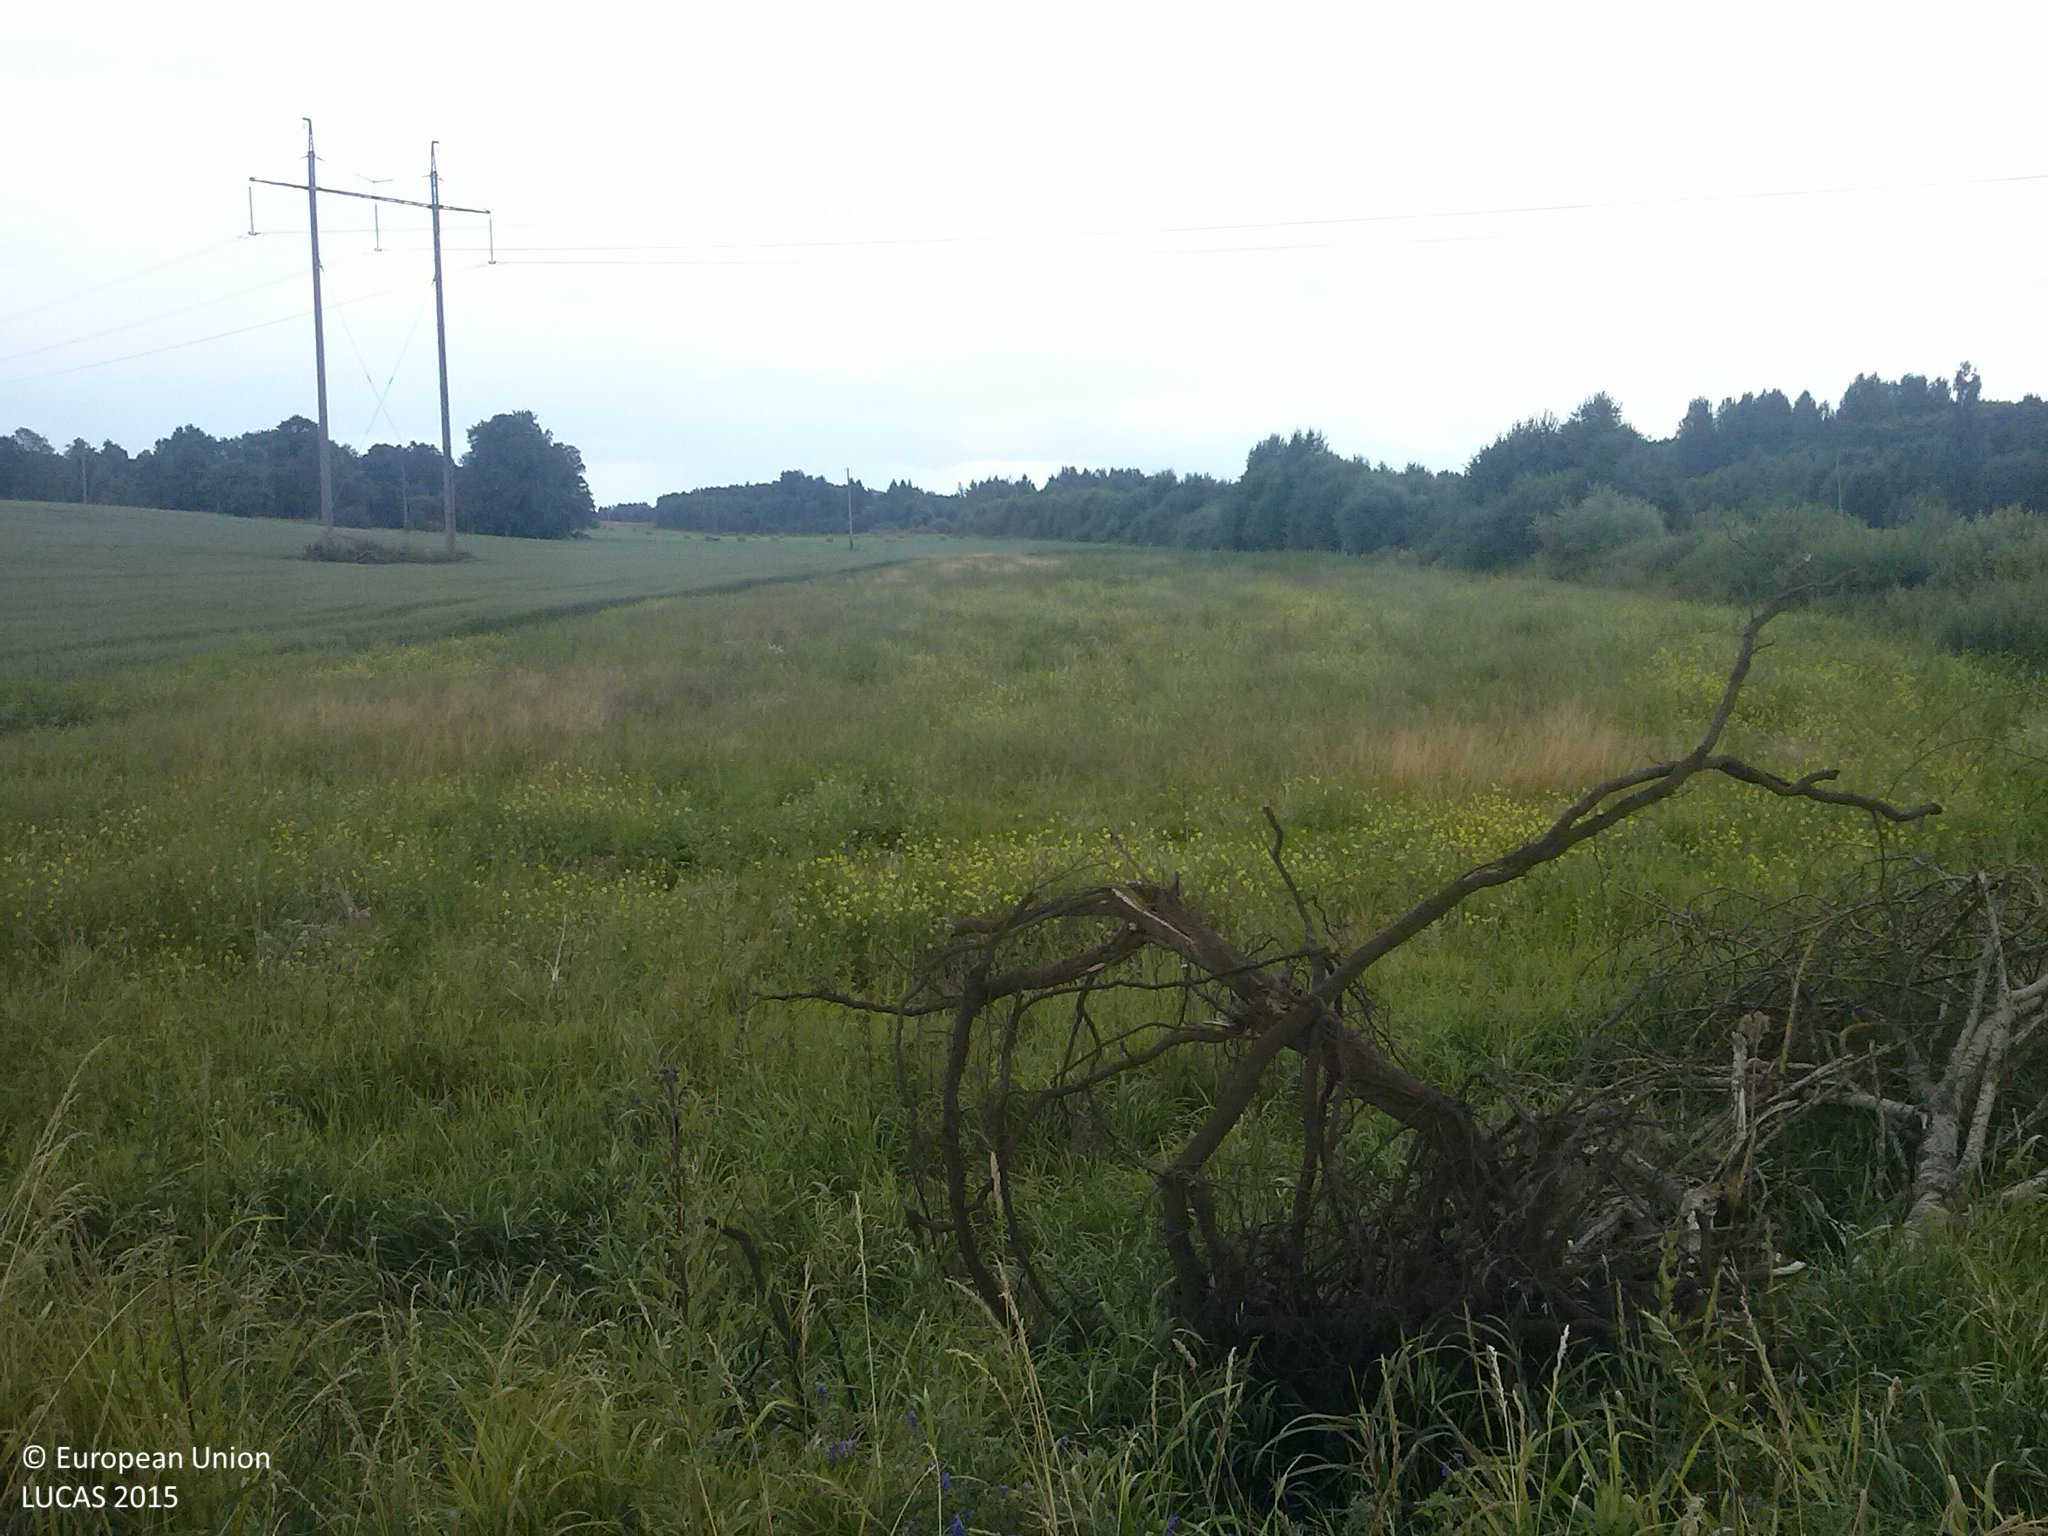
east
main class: Grassland
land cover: Grassland without tree/shrub cover
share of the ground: > 75 %
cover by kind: herbaceous plants 100 %
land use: Agriculture (excluding fallow land and kitchen gardens)
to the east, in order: Grassland without tree/shrub cover; Paved roads, cycling and walking lanes; Spontaneously vegetated surfaces; Common wheat; Electric lines; Common wheat
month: July
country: LV
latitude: 56.7176
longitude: 27.4130
